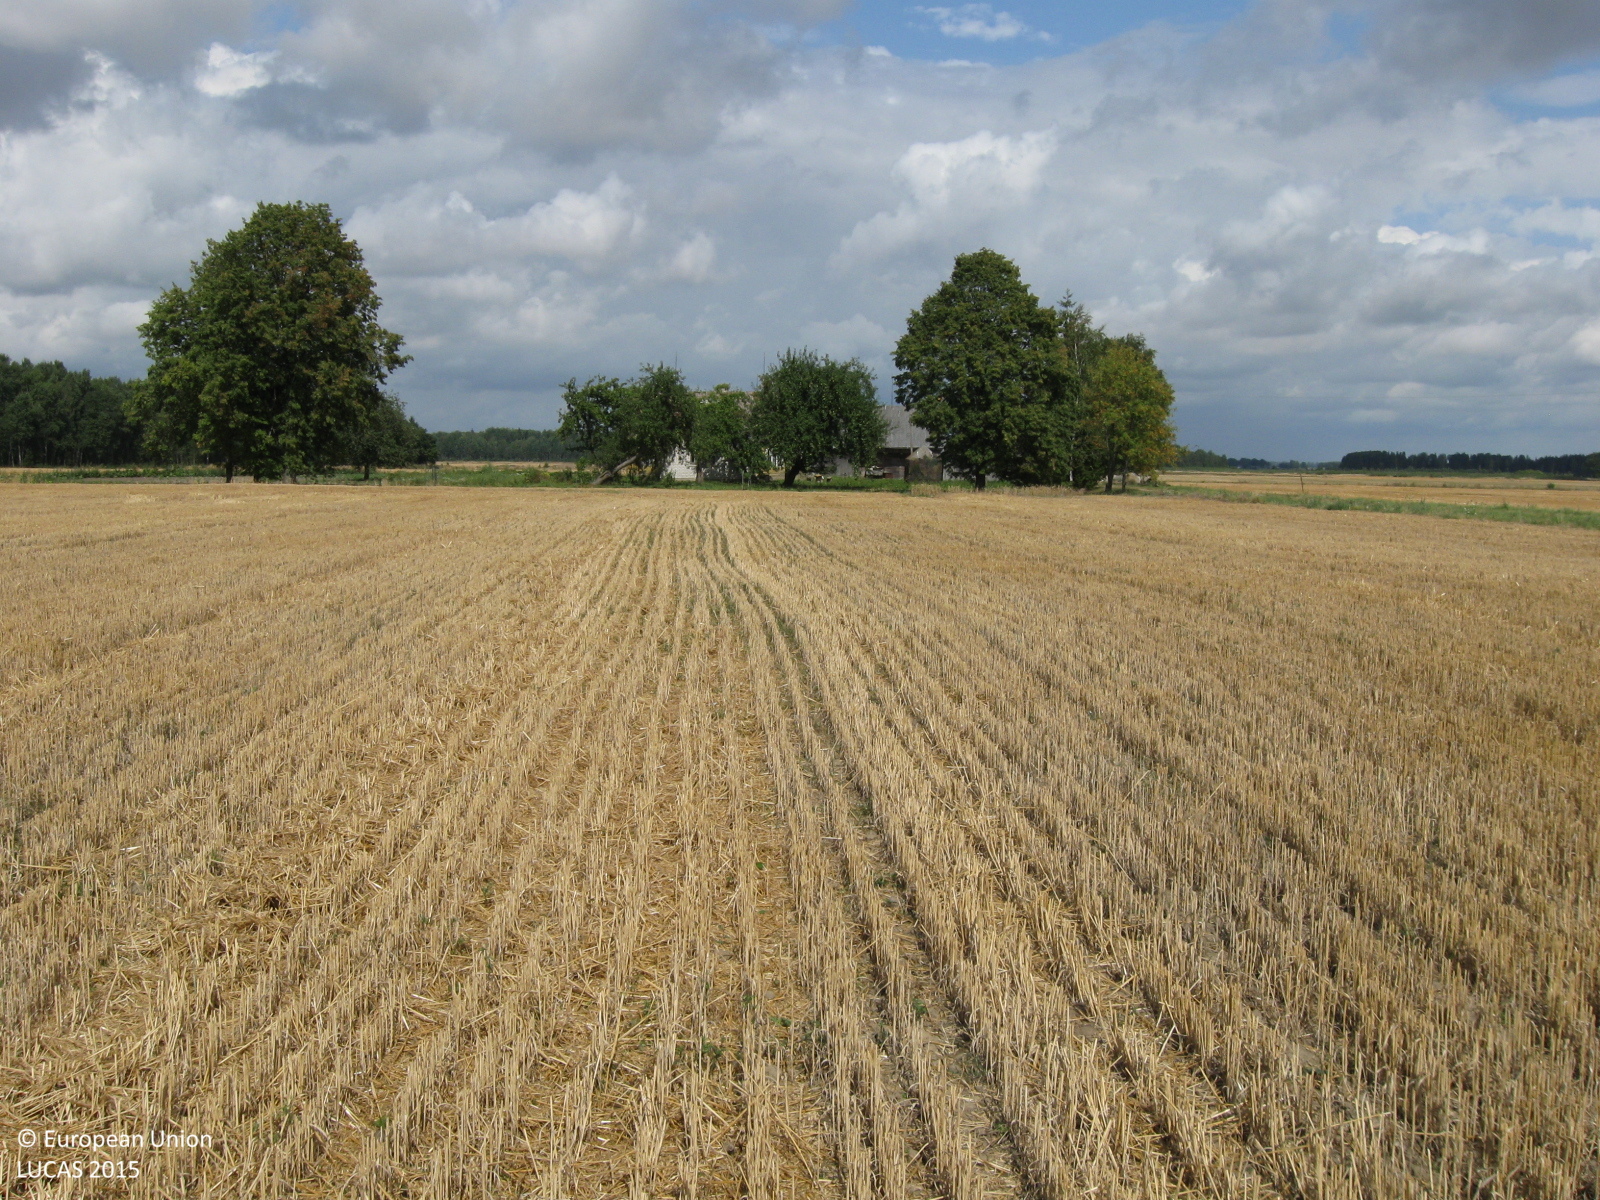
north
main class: Cropland
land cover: Common wheat
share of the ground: > 75 %
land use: Agriculture (excluding fallow land and kitchen gardens)
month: August
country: LT
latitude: 55.2521
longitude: 23.1464
